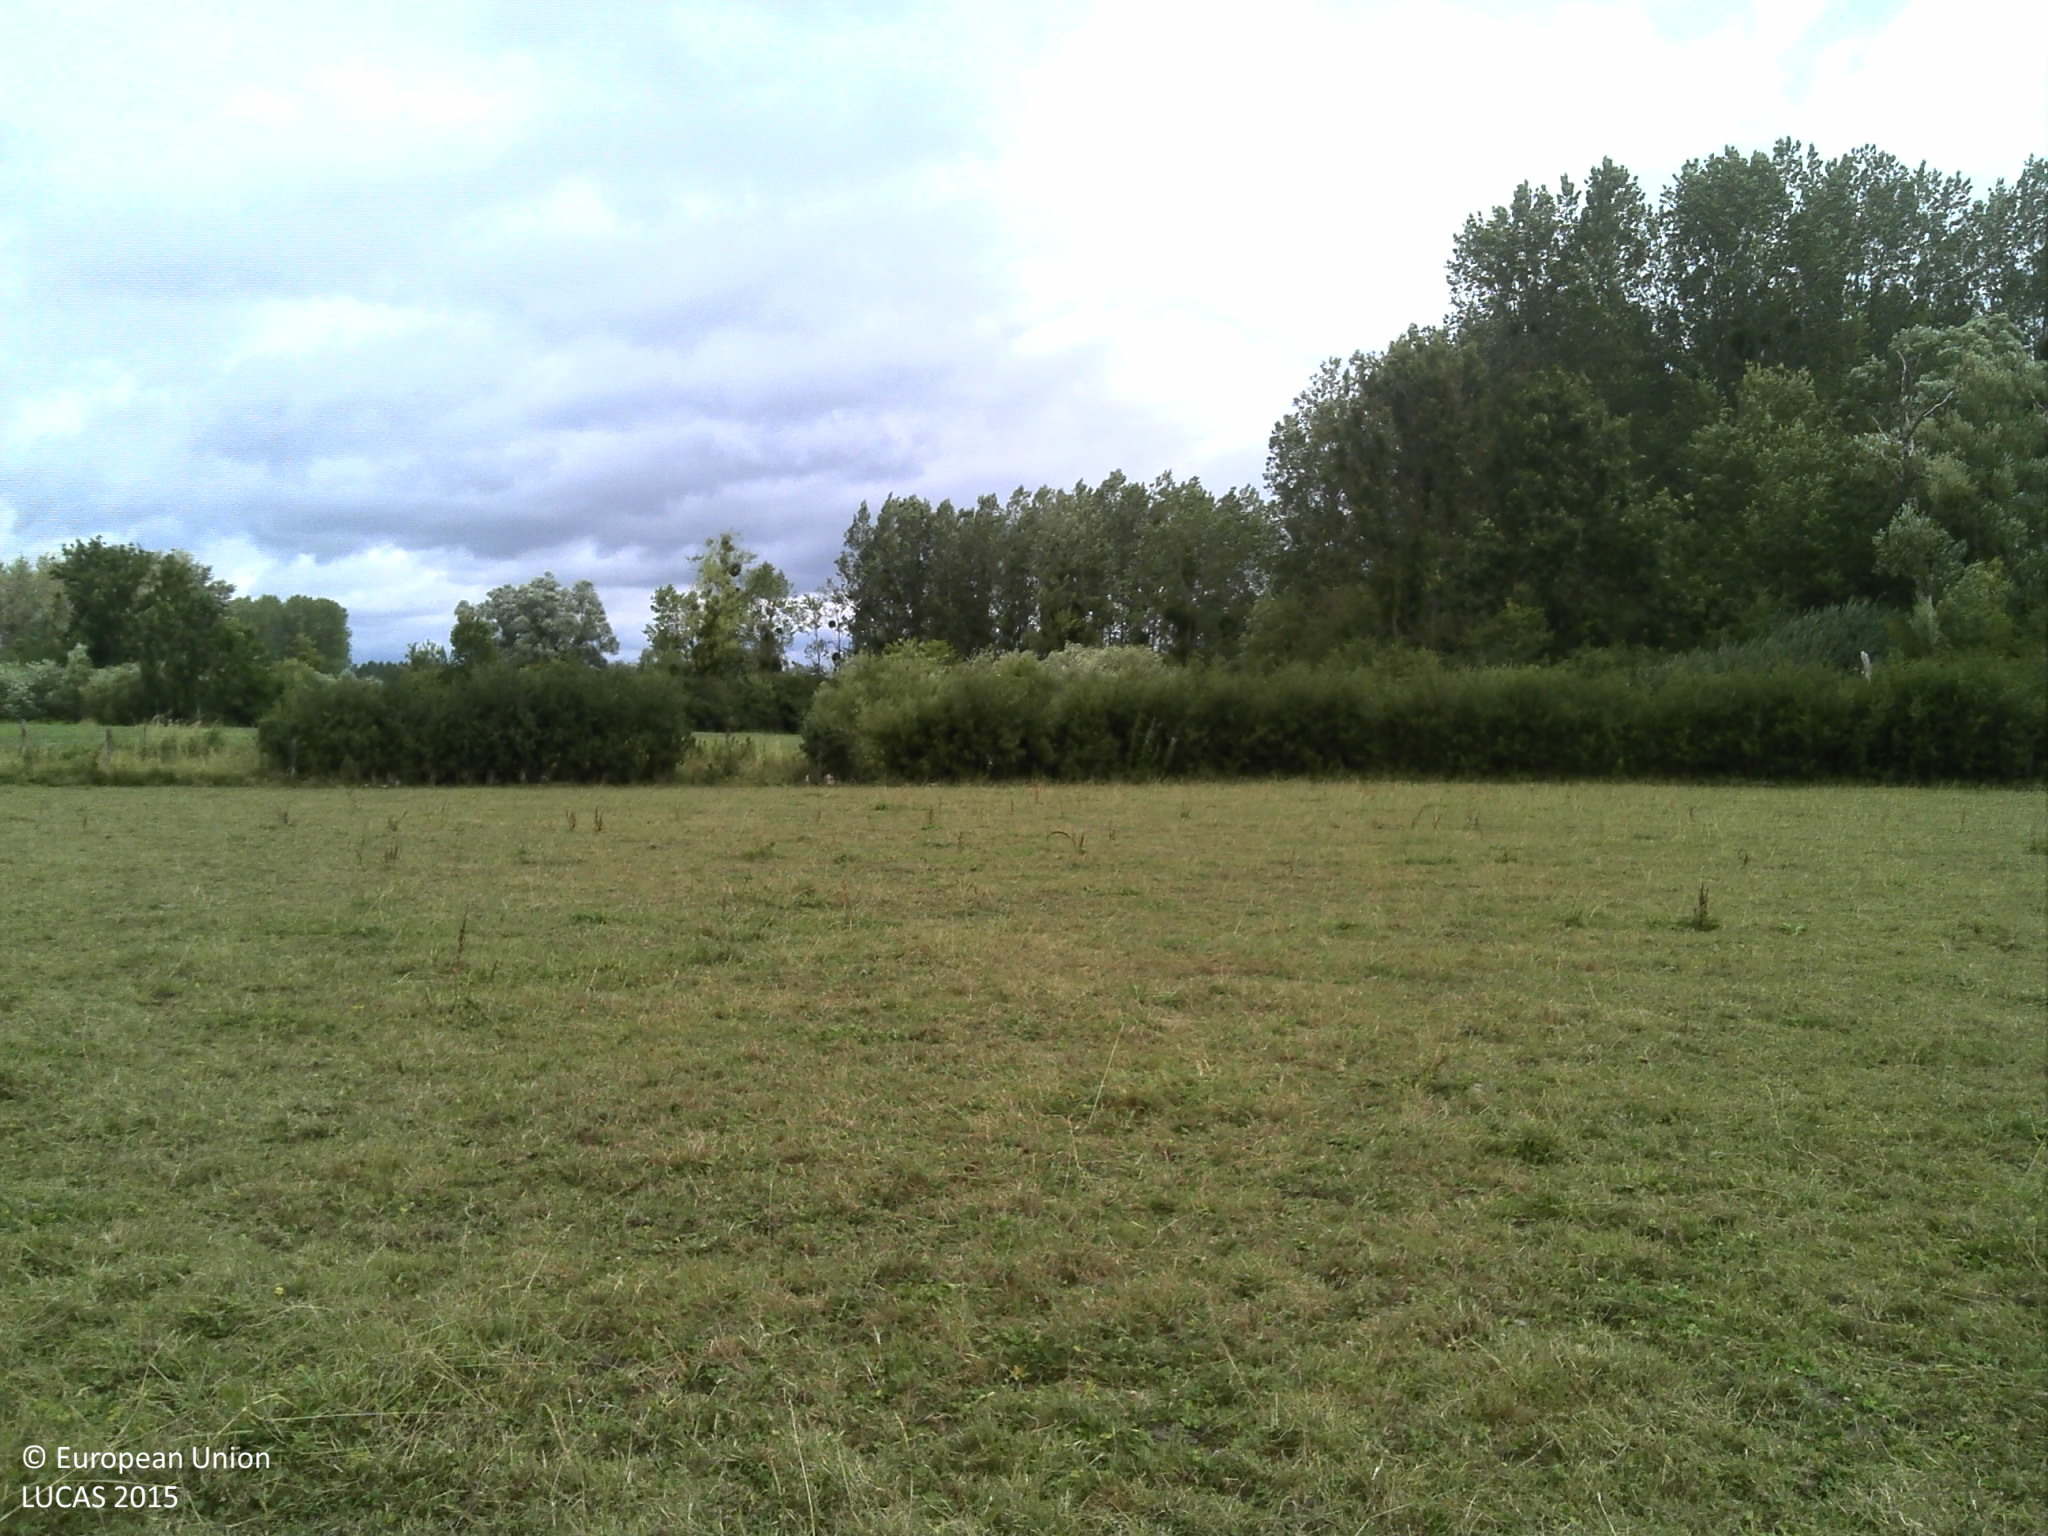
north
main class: Grassland
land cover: Grassland without tree/shrub cover
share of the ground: > 75 %
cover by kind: herbaceous plants 100 %
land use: Agriculture (excluding fallow land and kitchen gardens)
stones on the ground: < 10 %
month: July
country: FR
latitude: 49.4297
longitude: 4.6884
